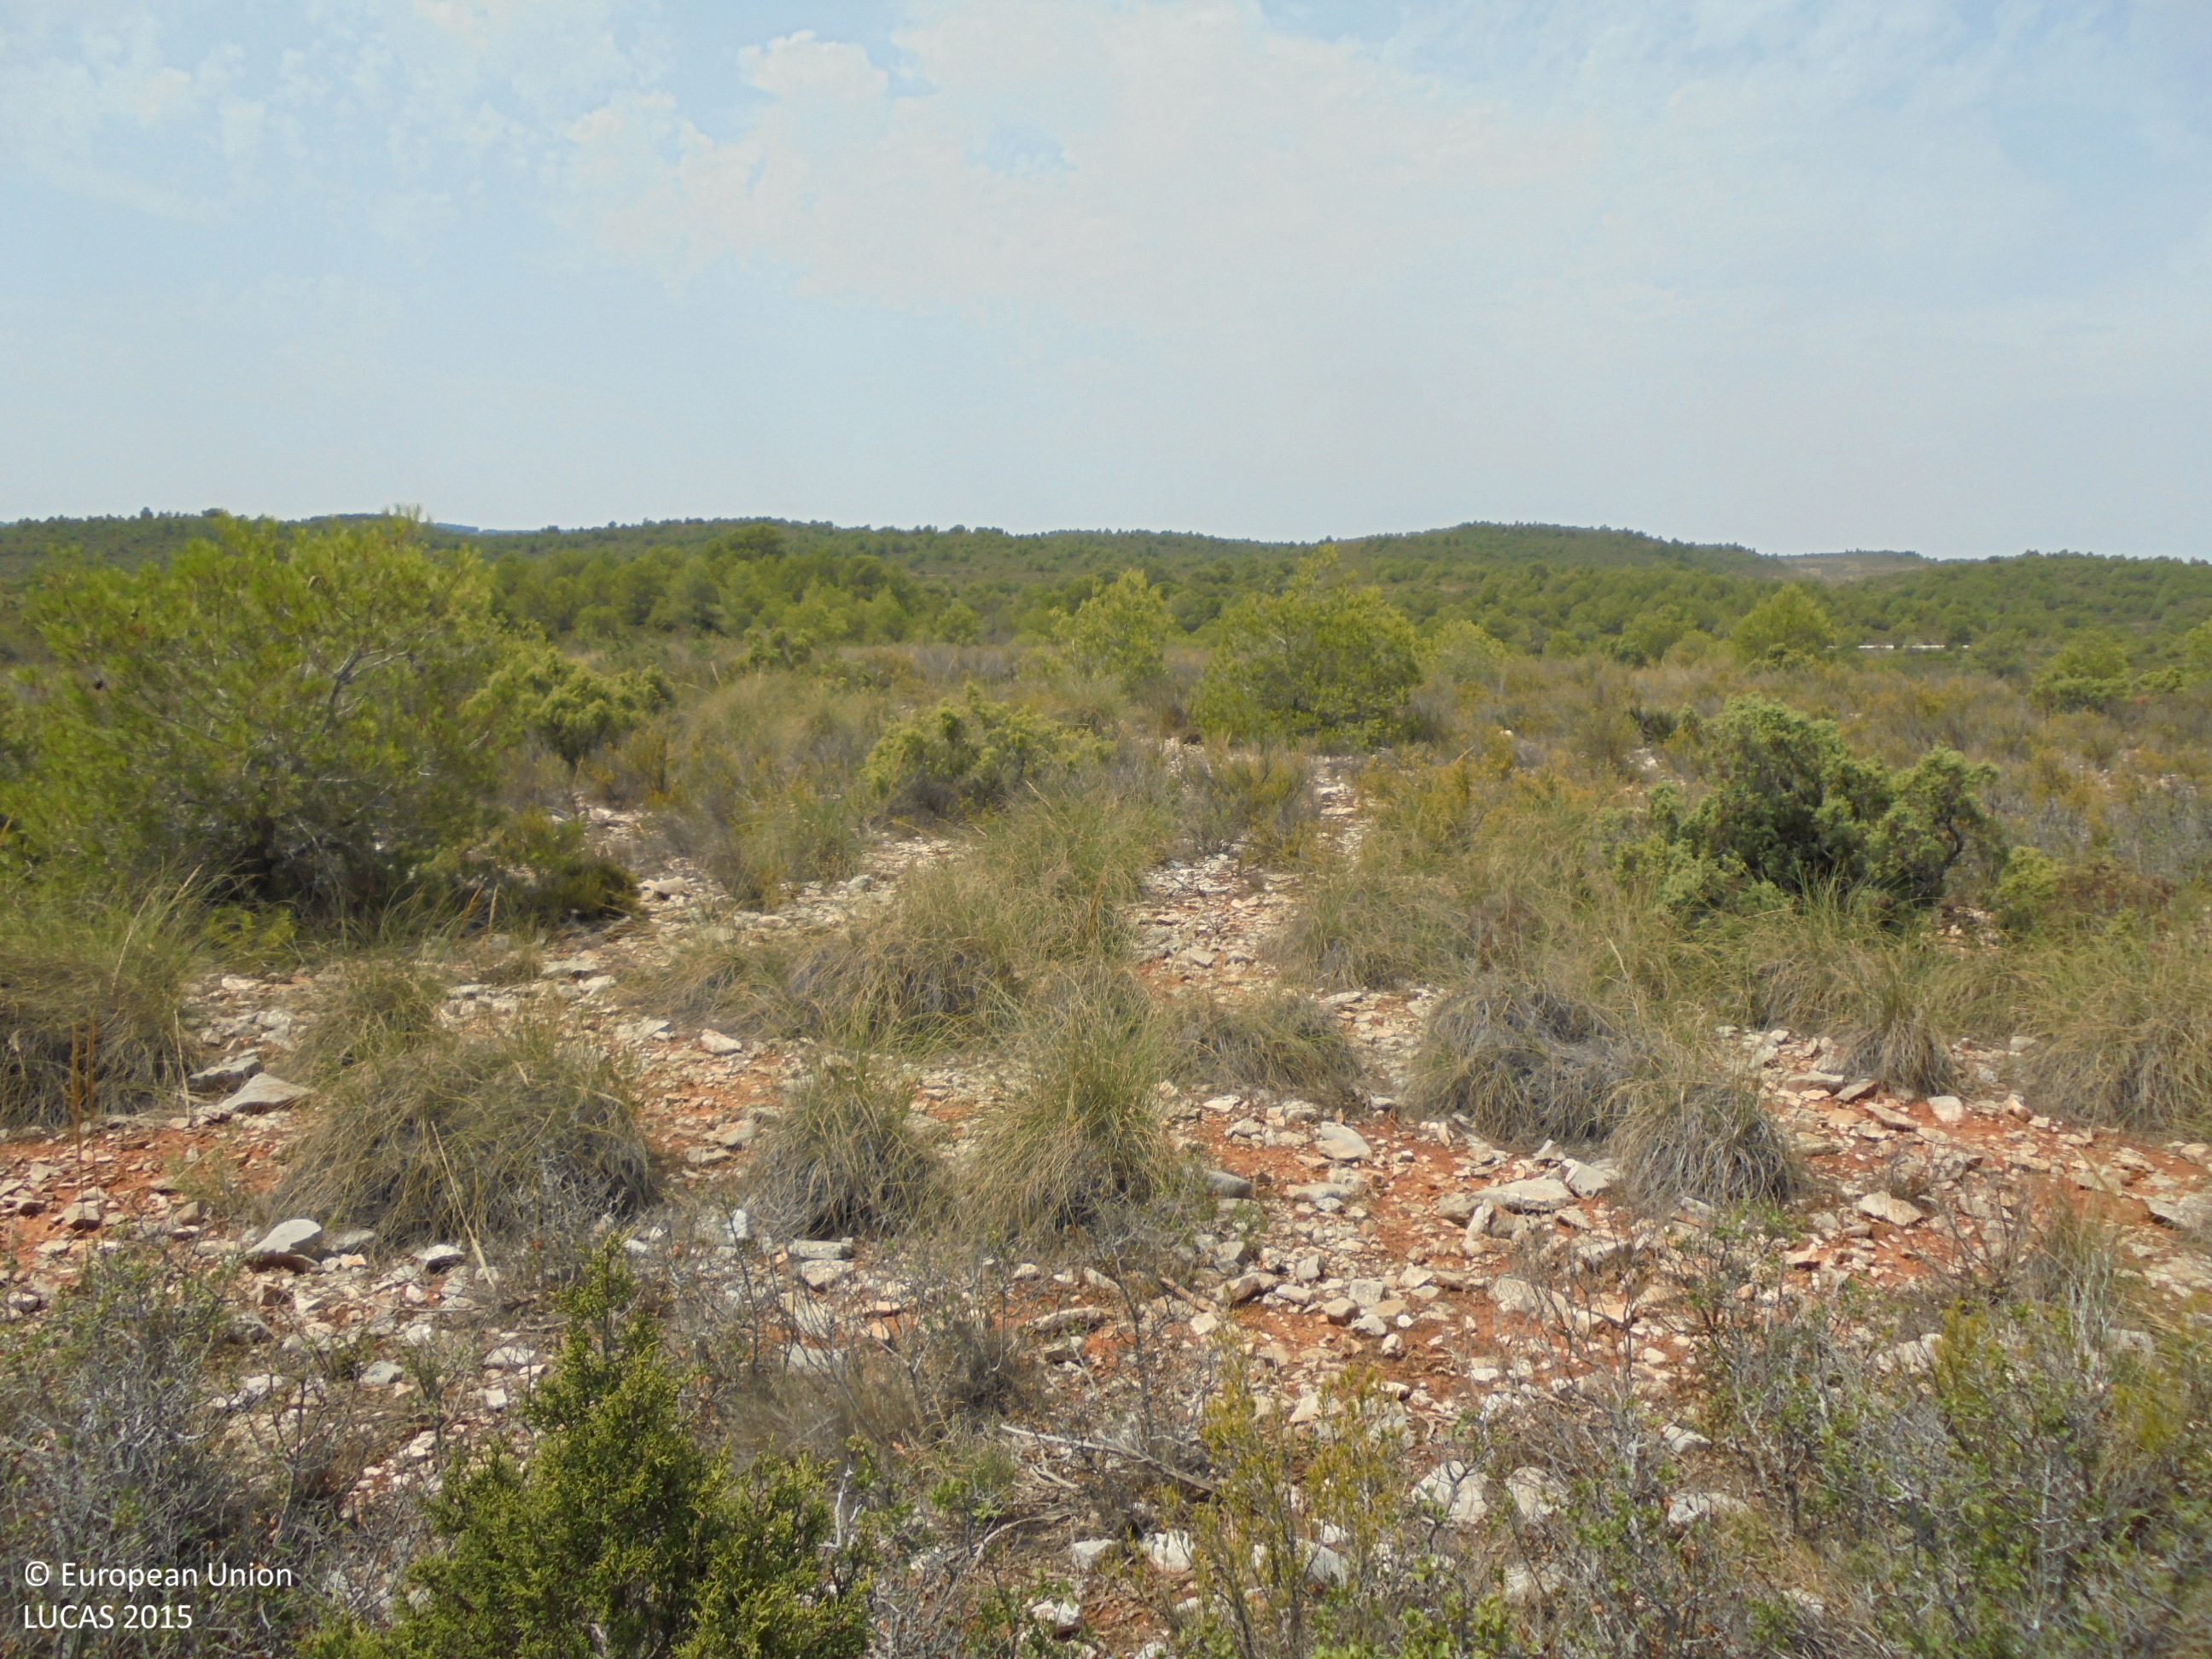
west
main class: Shrubland
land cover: Shrubland with sparse tree cover
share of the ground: > 75 %
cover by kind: shrubs 80 %, unconsolidated bare surface 15 %, coniferous forest trees 5 %
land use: Semi-natural and natural areas not in use
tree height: < 5 m
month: August
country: ES
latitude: 39.1720
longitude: -0.8418
